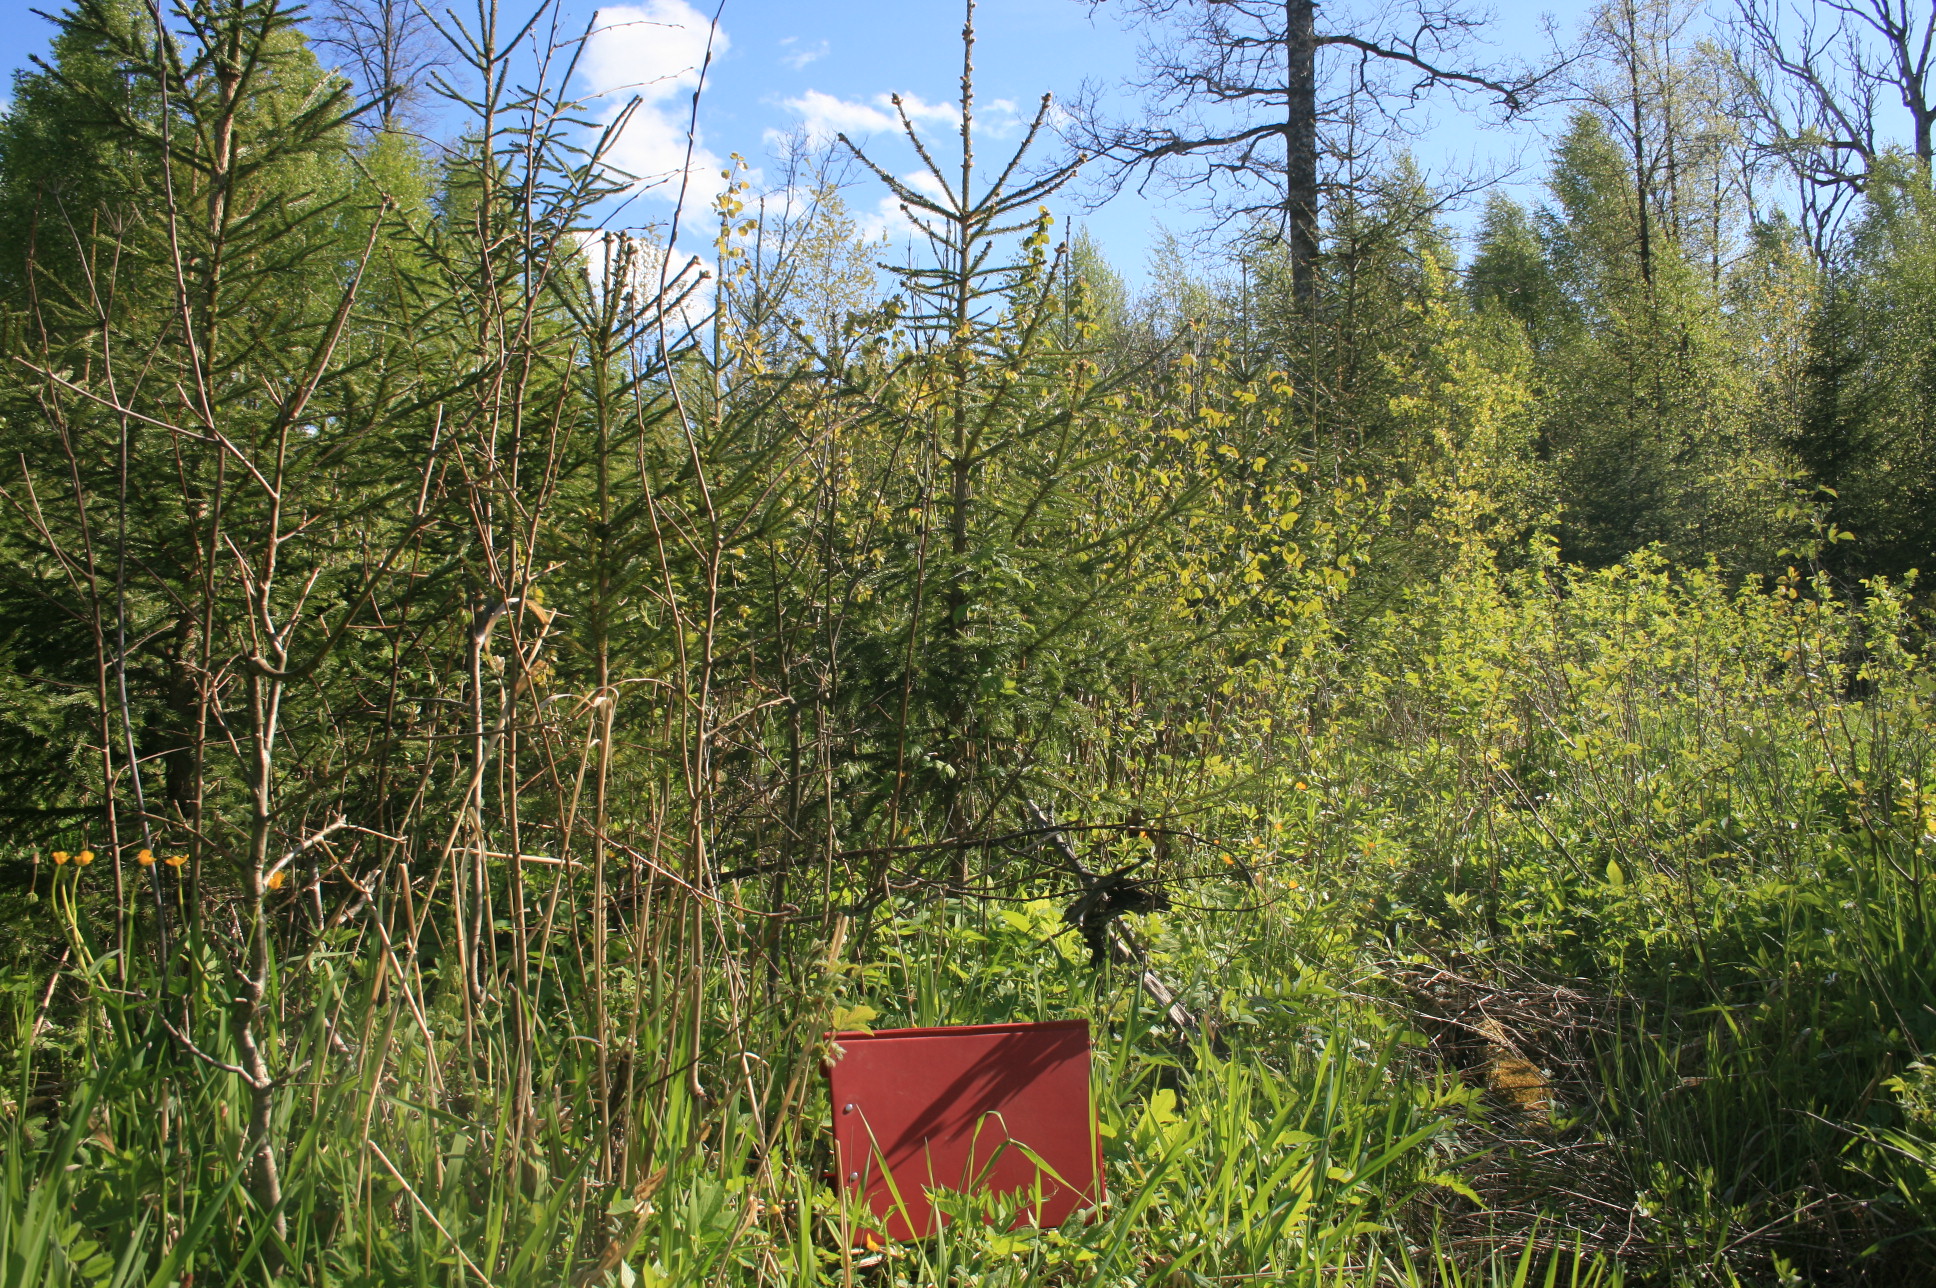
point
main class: Woodland
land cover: Spruce dominated mixed woodland
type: hemiboreal forest and nemoral coniferous forest and mixed broadleaved-coniferous forest
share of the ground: > 75 %
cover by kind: coniferous forest trees 65 %, broadleaved forest trees 25 %, herbaceous plants 10 %
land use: Forestry
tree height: < 5 m
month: May
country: LT
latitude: 56.0340
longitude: 21.6820
